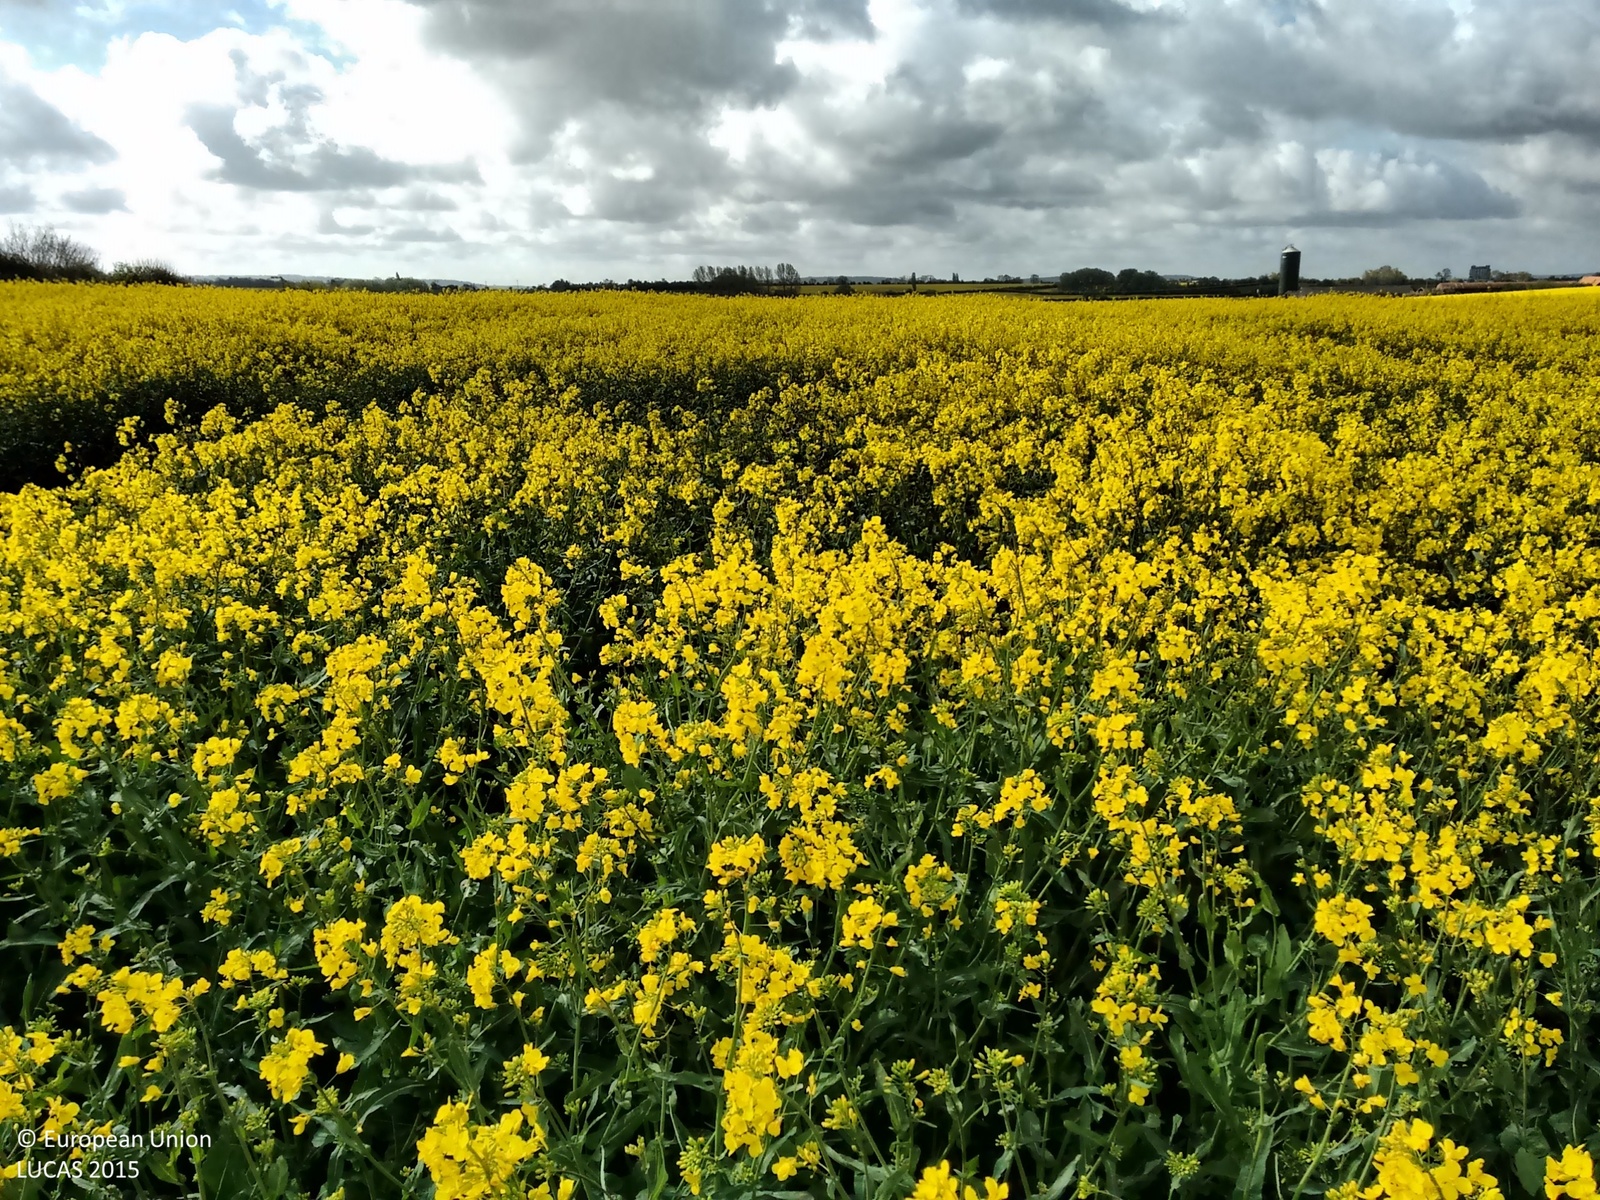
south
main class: Cropland
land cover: Rape and turnip rape
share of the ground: > 75 %
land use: Agriculture (excluding fallow land and kitchen gardens)
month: April
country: GB
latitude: 51.8470
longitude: -0.7985
